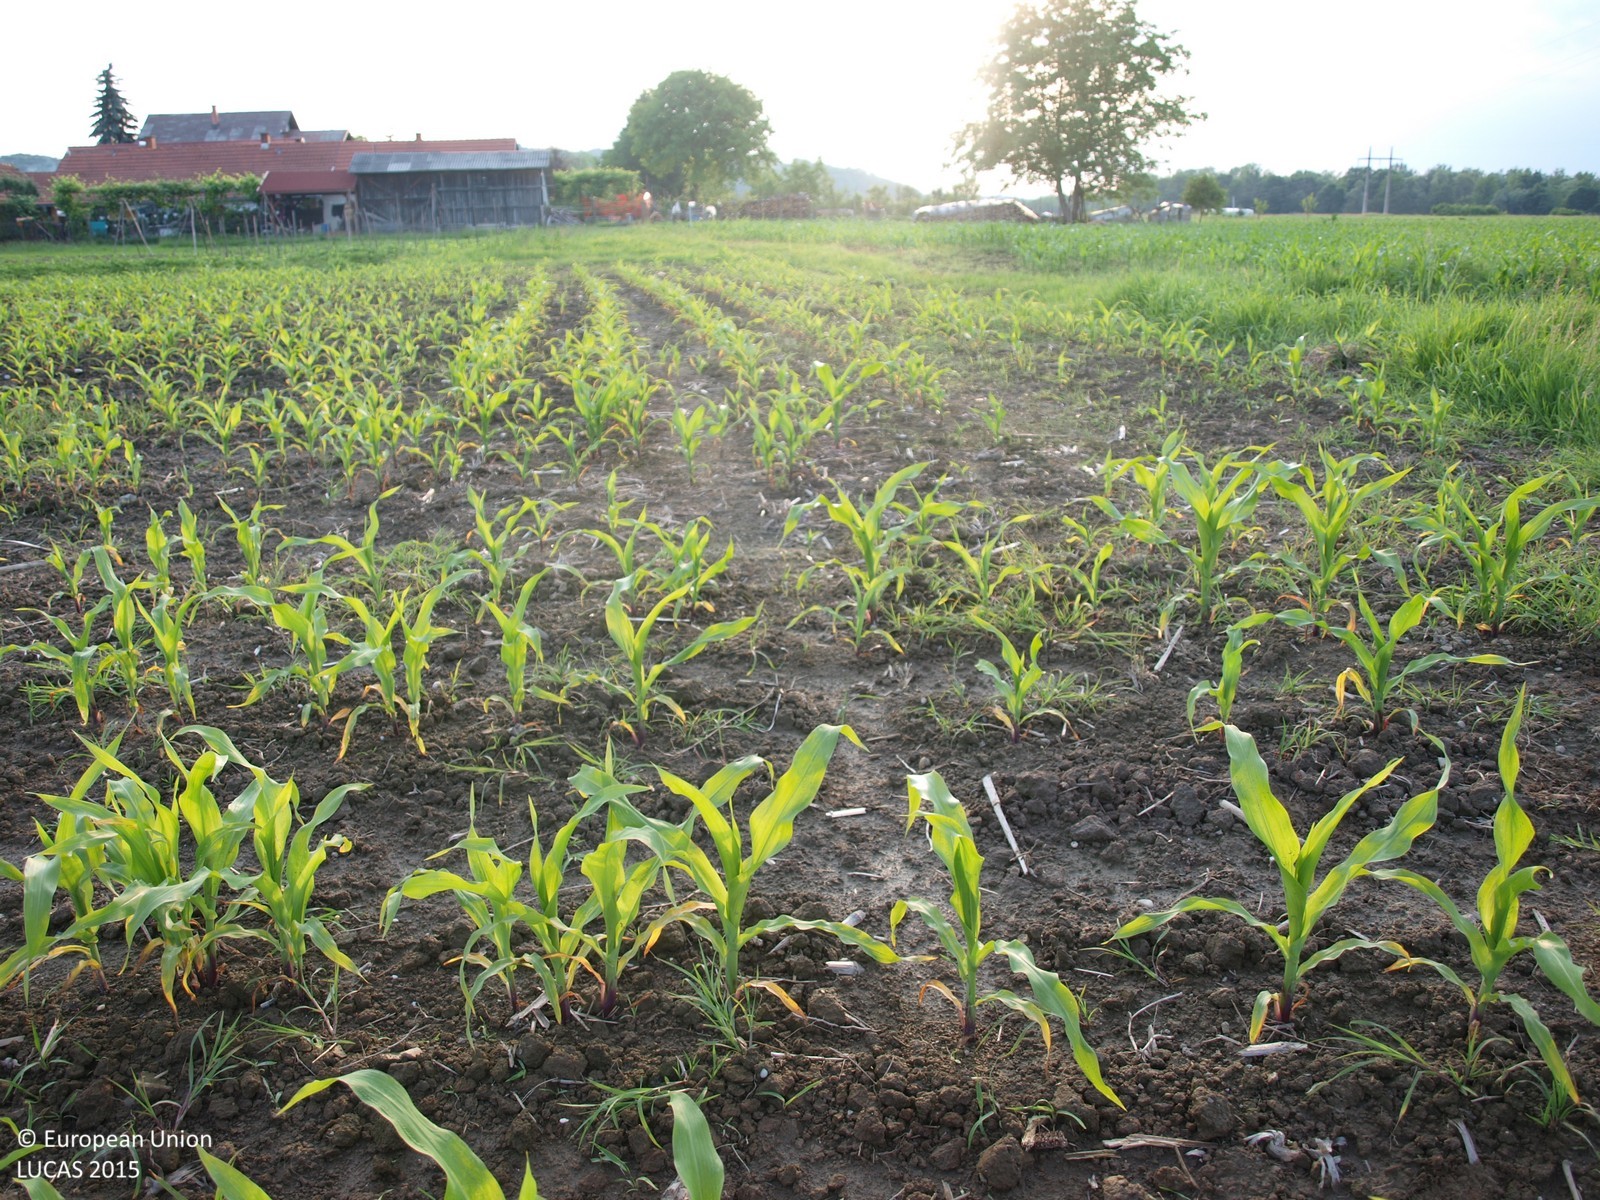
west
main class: Cropland
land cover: Maize
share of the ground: 10 - 25 %
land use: Agriculture (excluding fallow land and kitchen gardens)
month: June
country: HR
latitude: 46.3759
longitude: 16.0970
